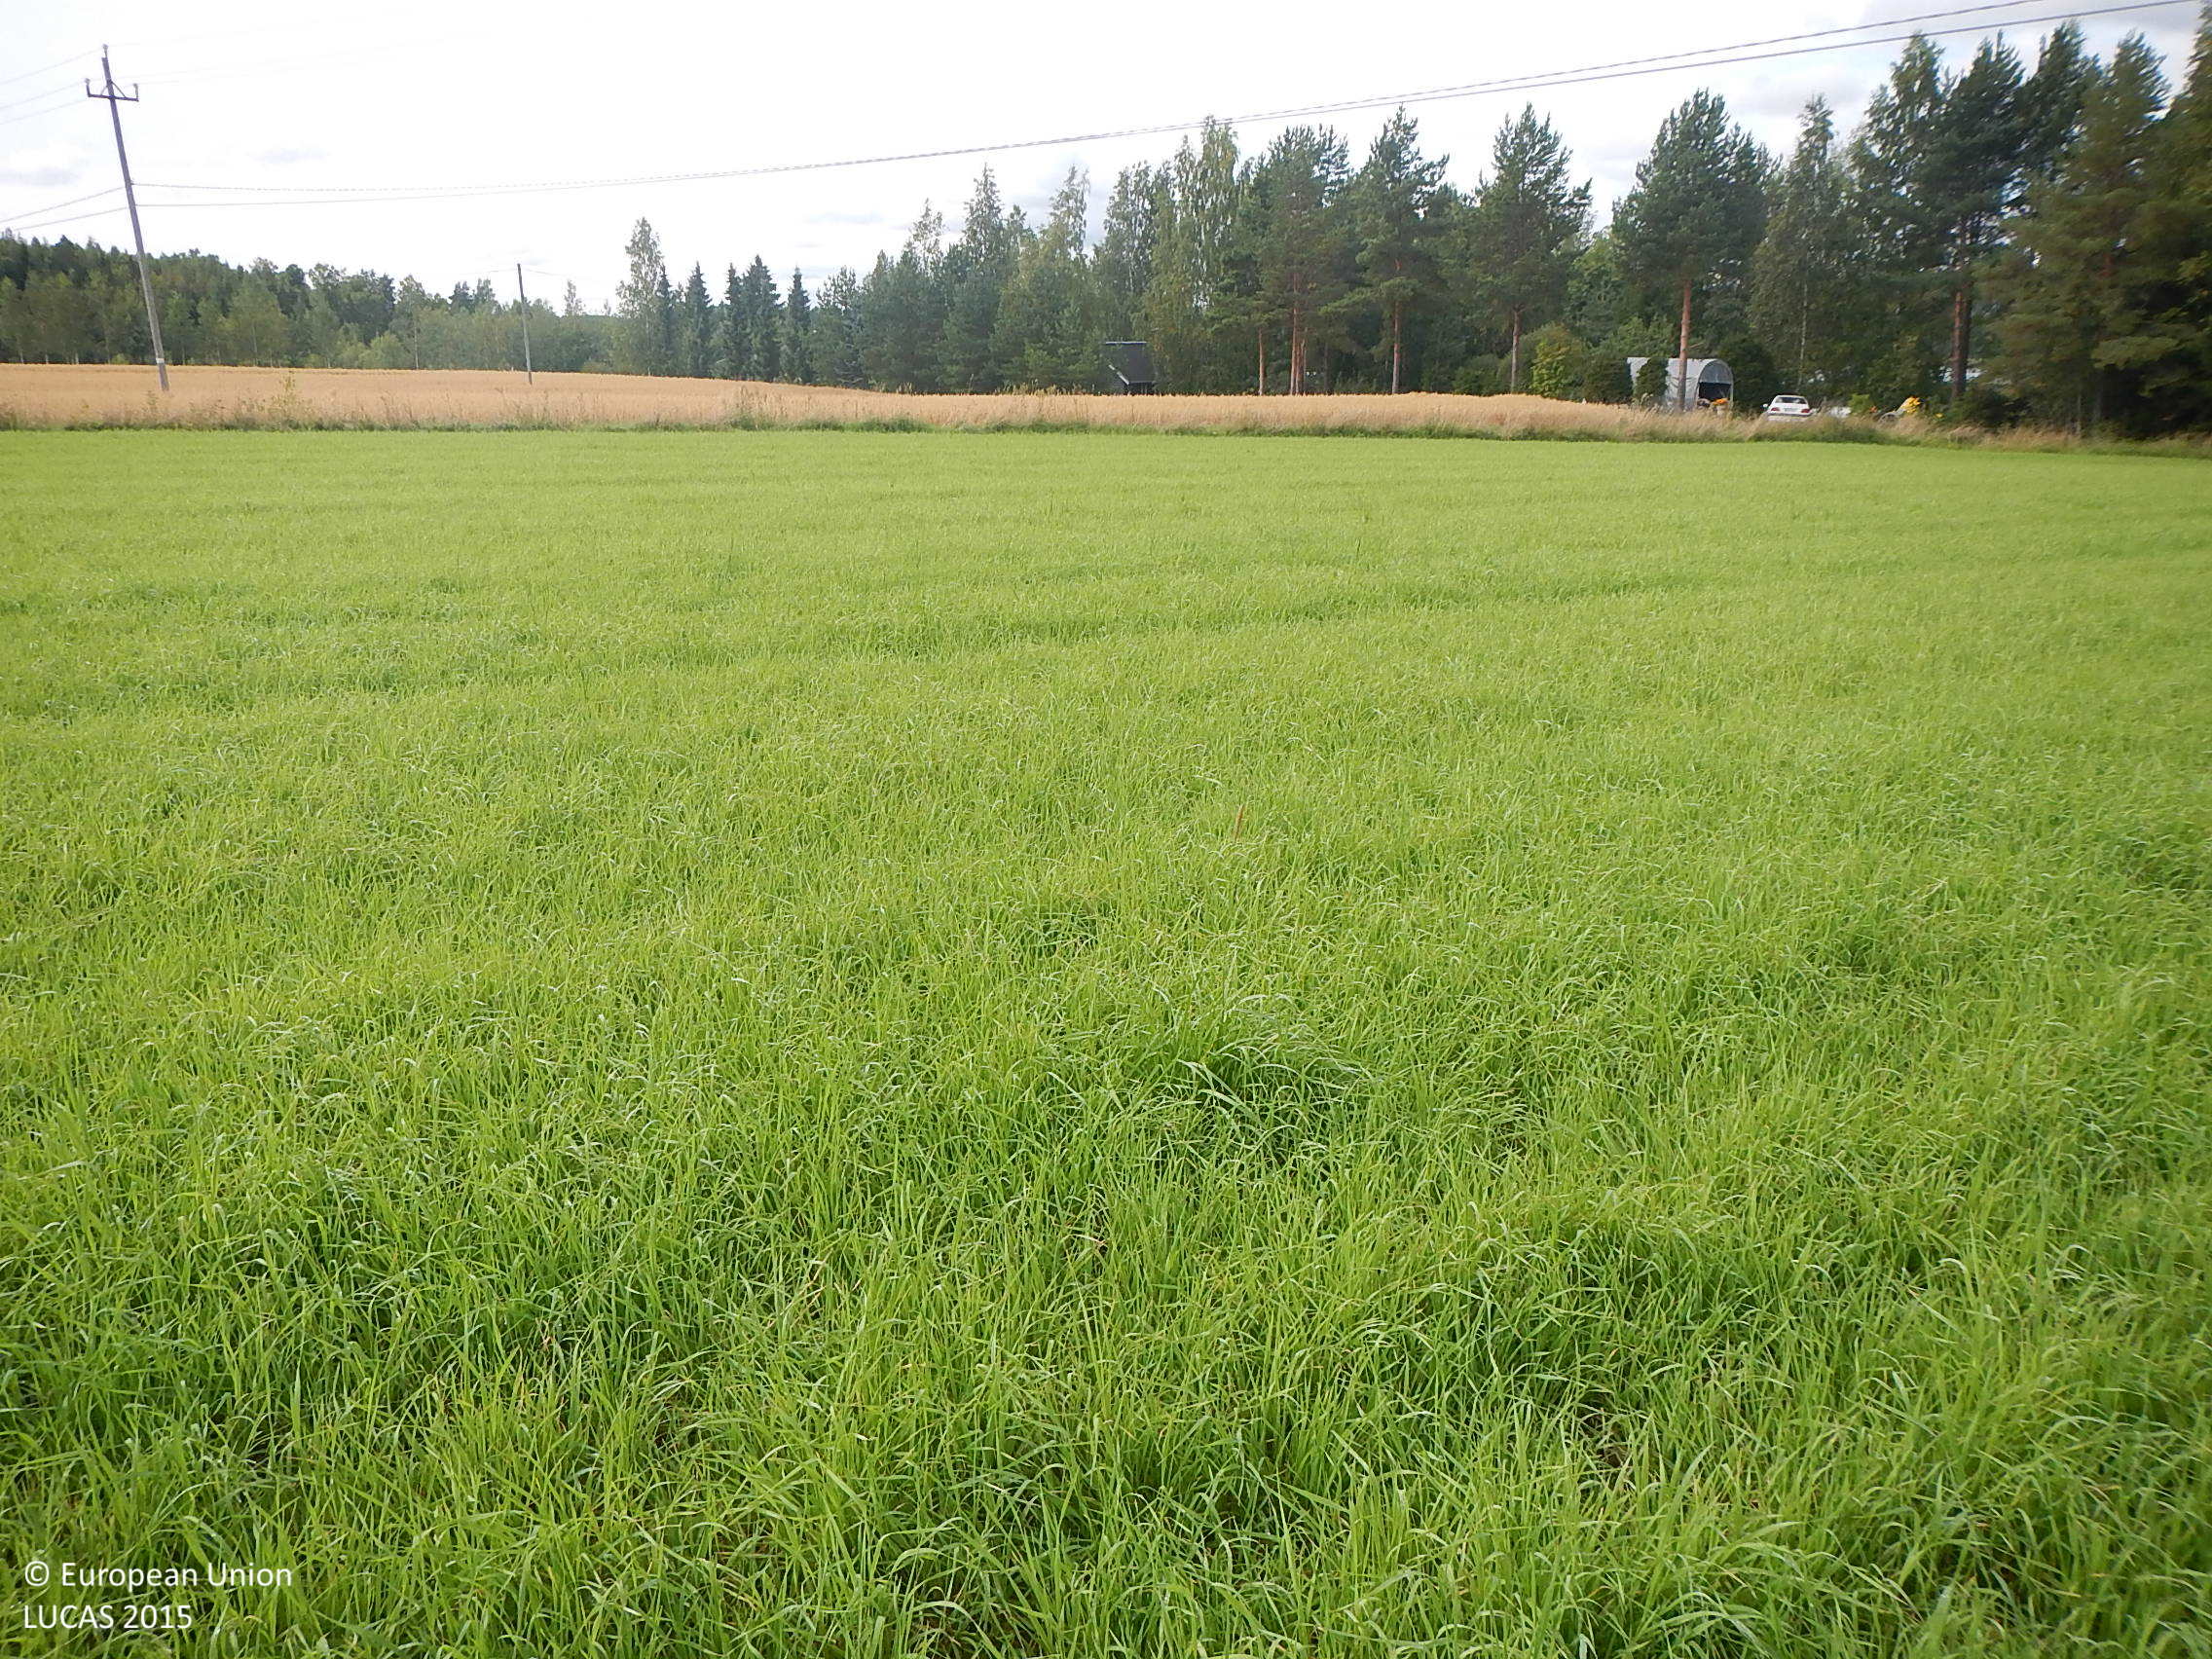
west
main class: Cropland
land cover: Temporary grasslands
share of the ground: > 75 %
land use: Agriculture (excluding fallow land and kitchen gardens)
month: September
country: FI
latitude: 61.4357
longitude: 23.0649
